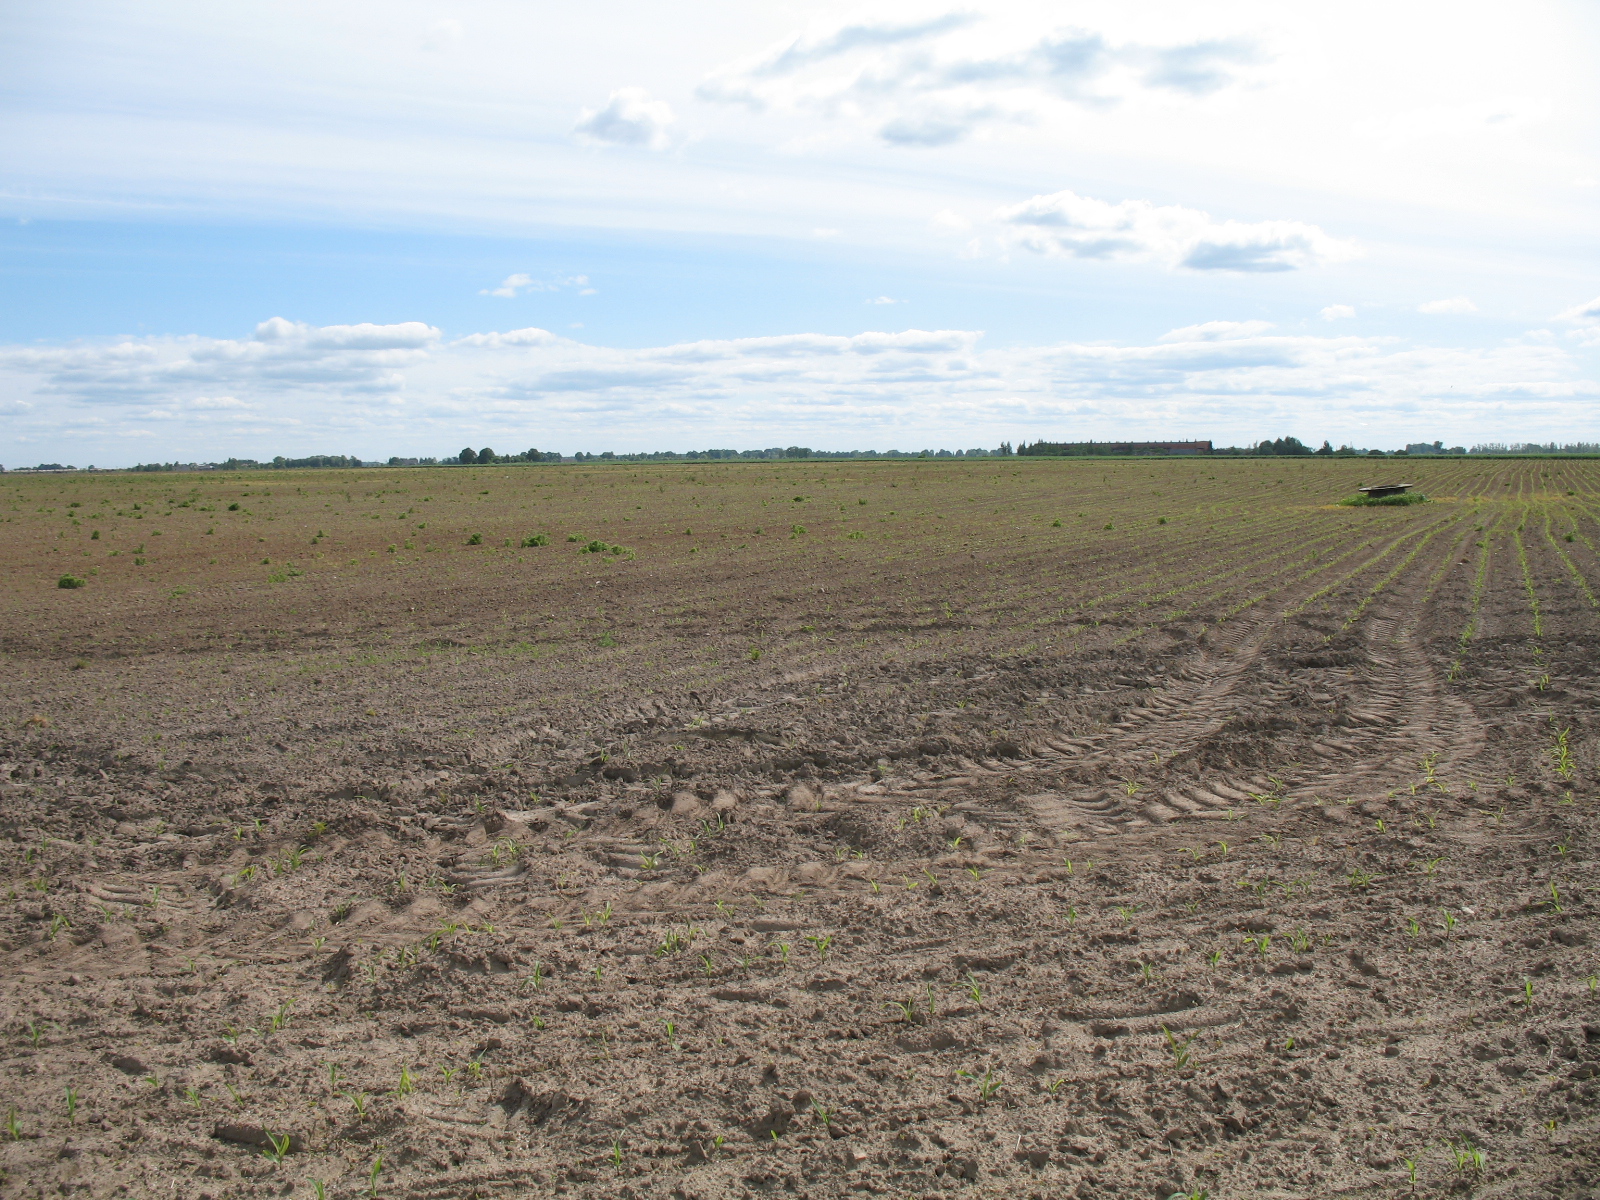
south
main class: Cropland
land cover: Maize
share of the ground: < 10 %
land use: Agriculture (excluding fallow land and kitchen gardens)
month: June
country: LV
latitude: 56.6218
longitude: 23.4873
